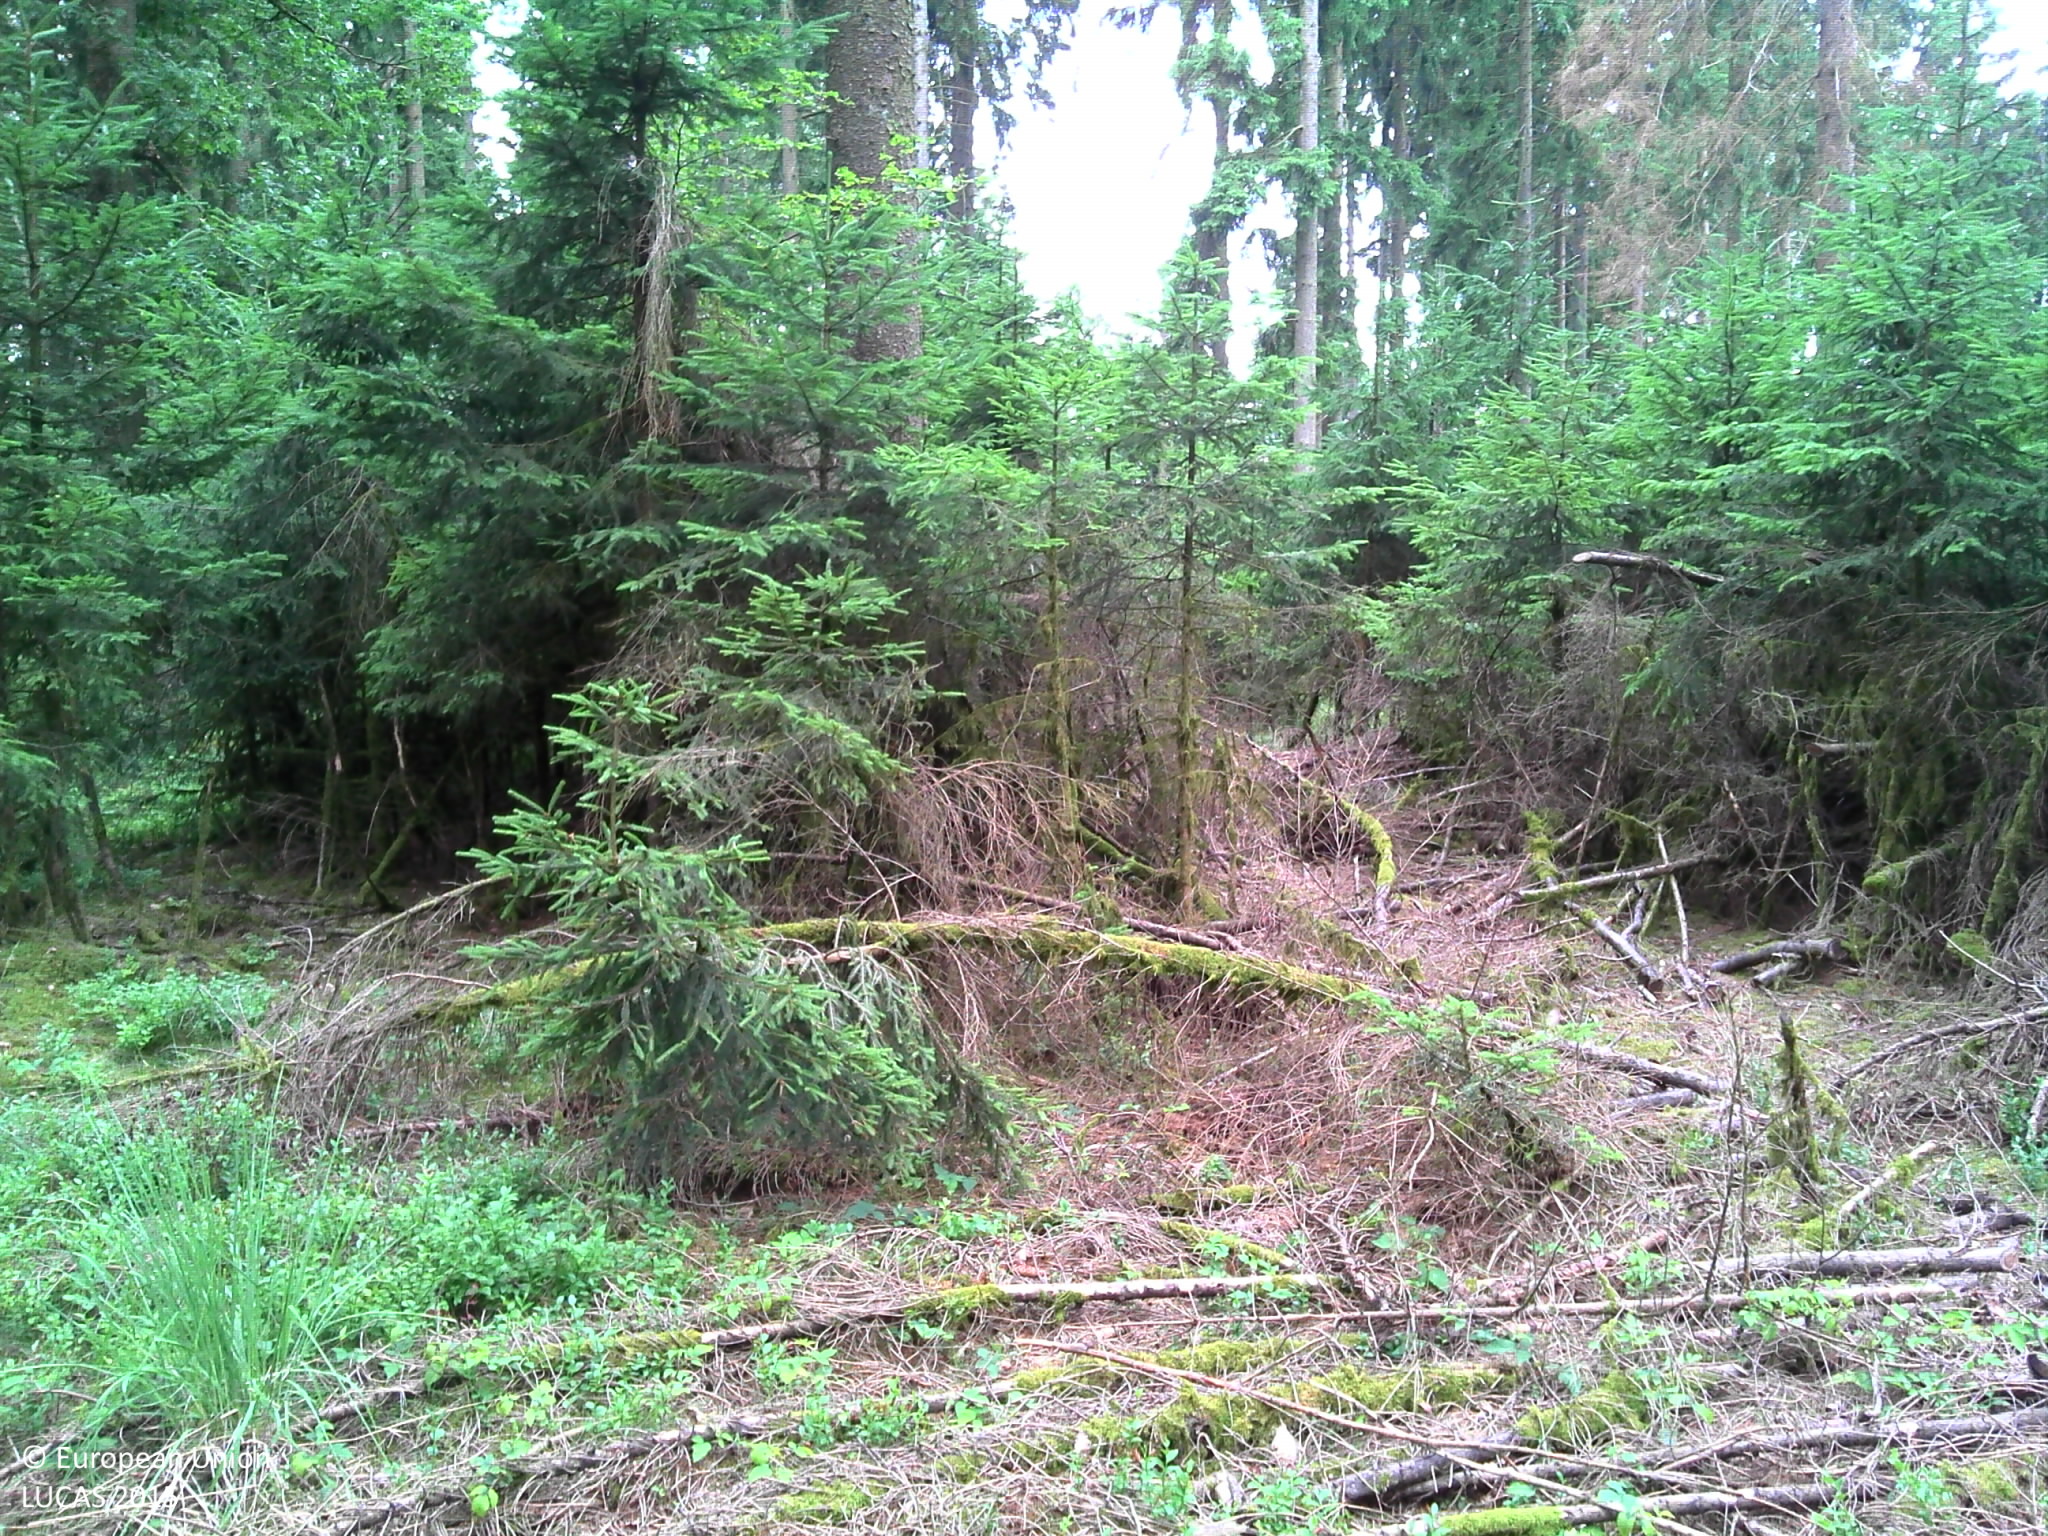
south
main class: Woodland
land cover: Spruce dominated coniferous woodland
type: hemiboreal forest and nemoral coniferous forest and mixed broadleaved-coniferous forest
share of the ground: 50 - 75 %
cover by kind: coniferous forest trees 60 %, herbaceous plants 20 %, shrubs 10 %, unconsolidated bare surface 10 %
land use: Forestry
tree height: > 5 m
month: July
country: BE
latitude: 49.7571
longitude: 5.5983
